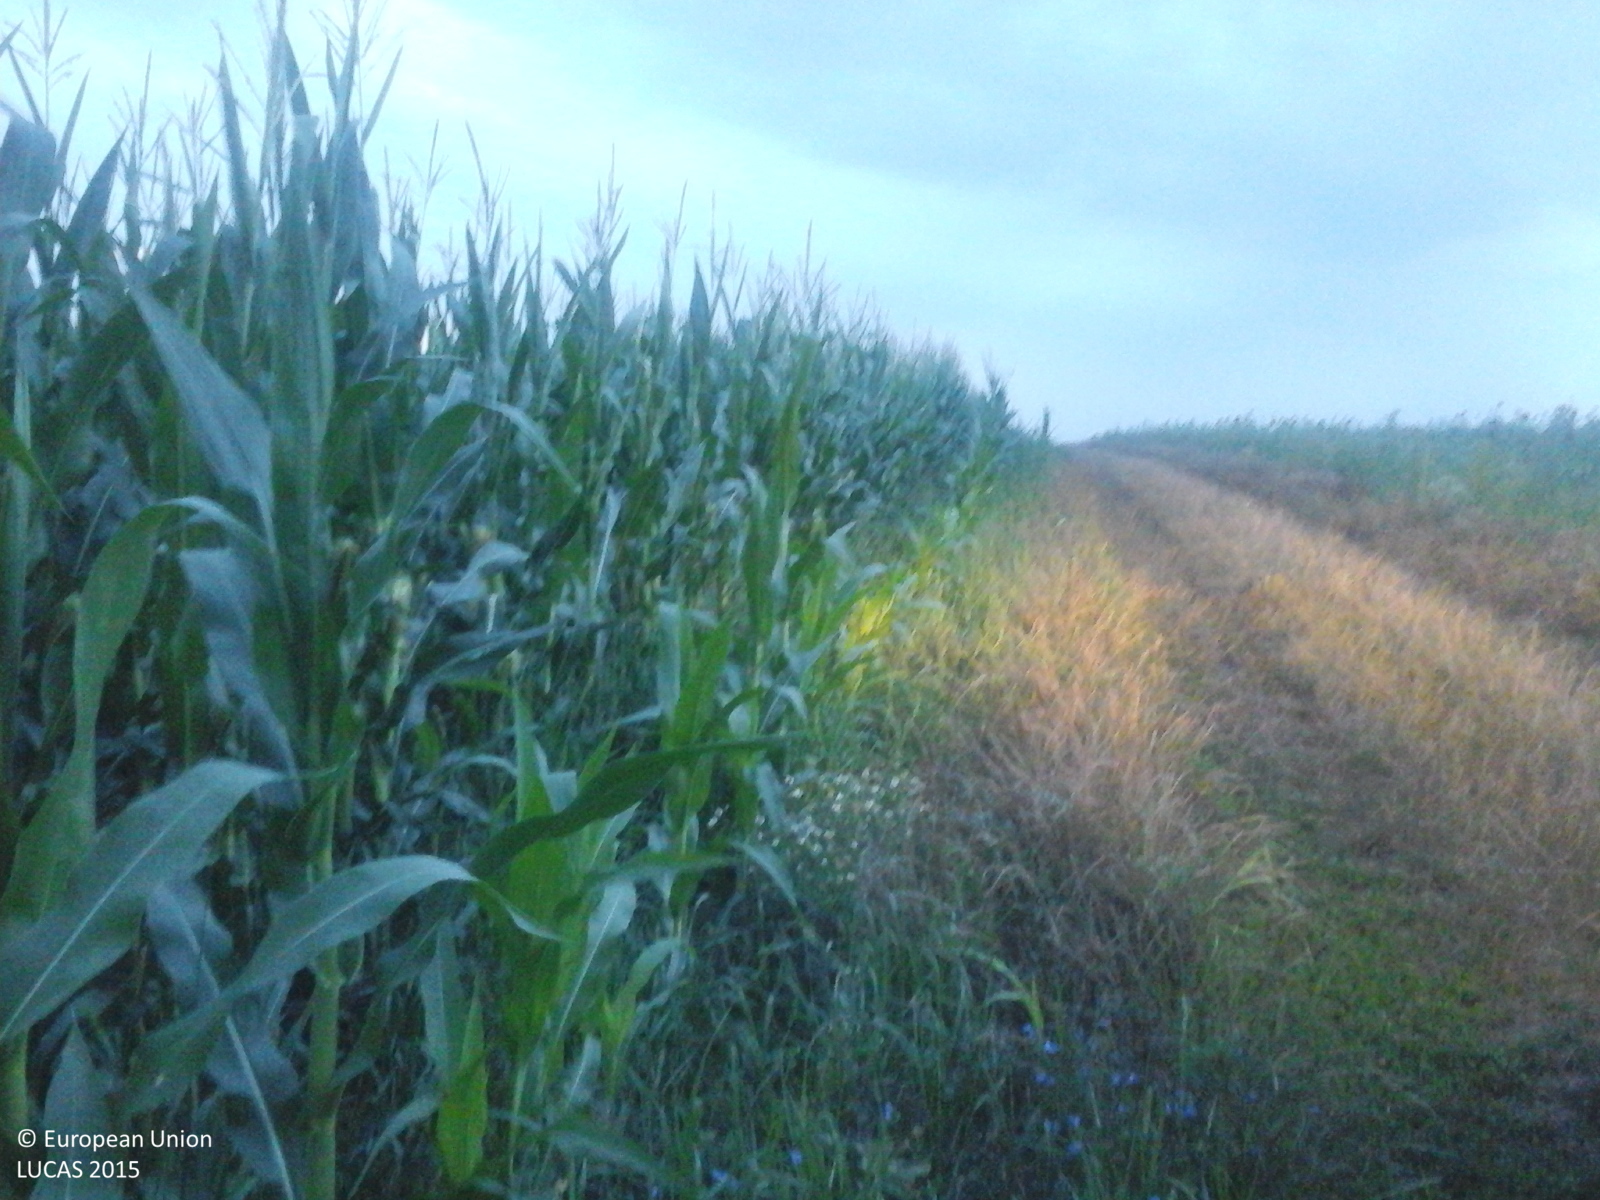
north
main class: Cropland
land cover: Maize
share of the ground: > 75 %
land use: Agriculture (excluding fallow land and kitchen gardens)
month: July
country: RO
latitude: 44.0910
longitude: 24.2641
